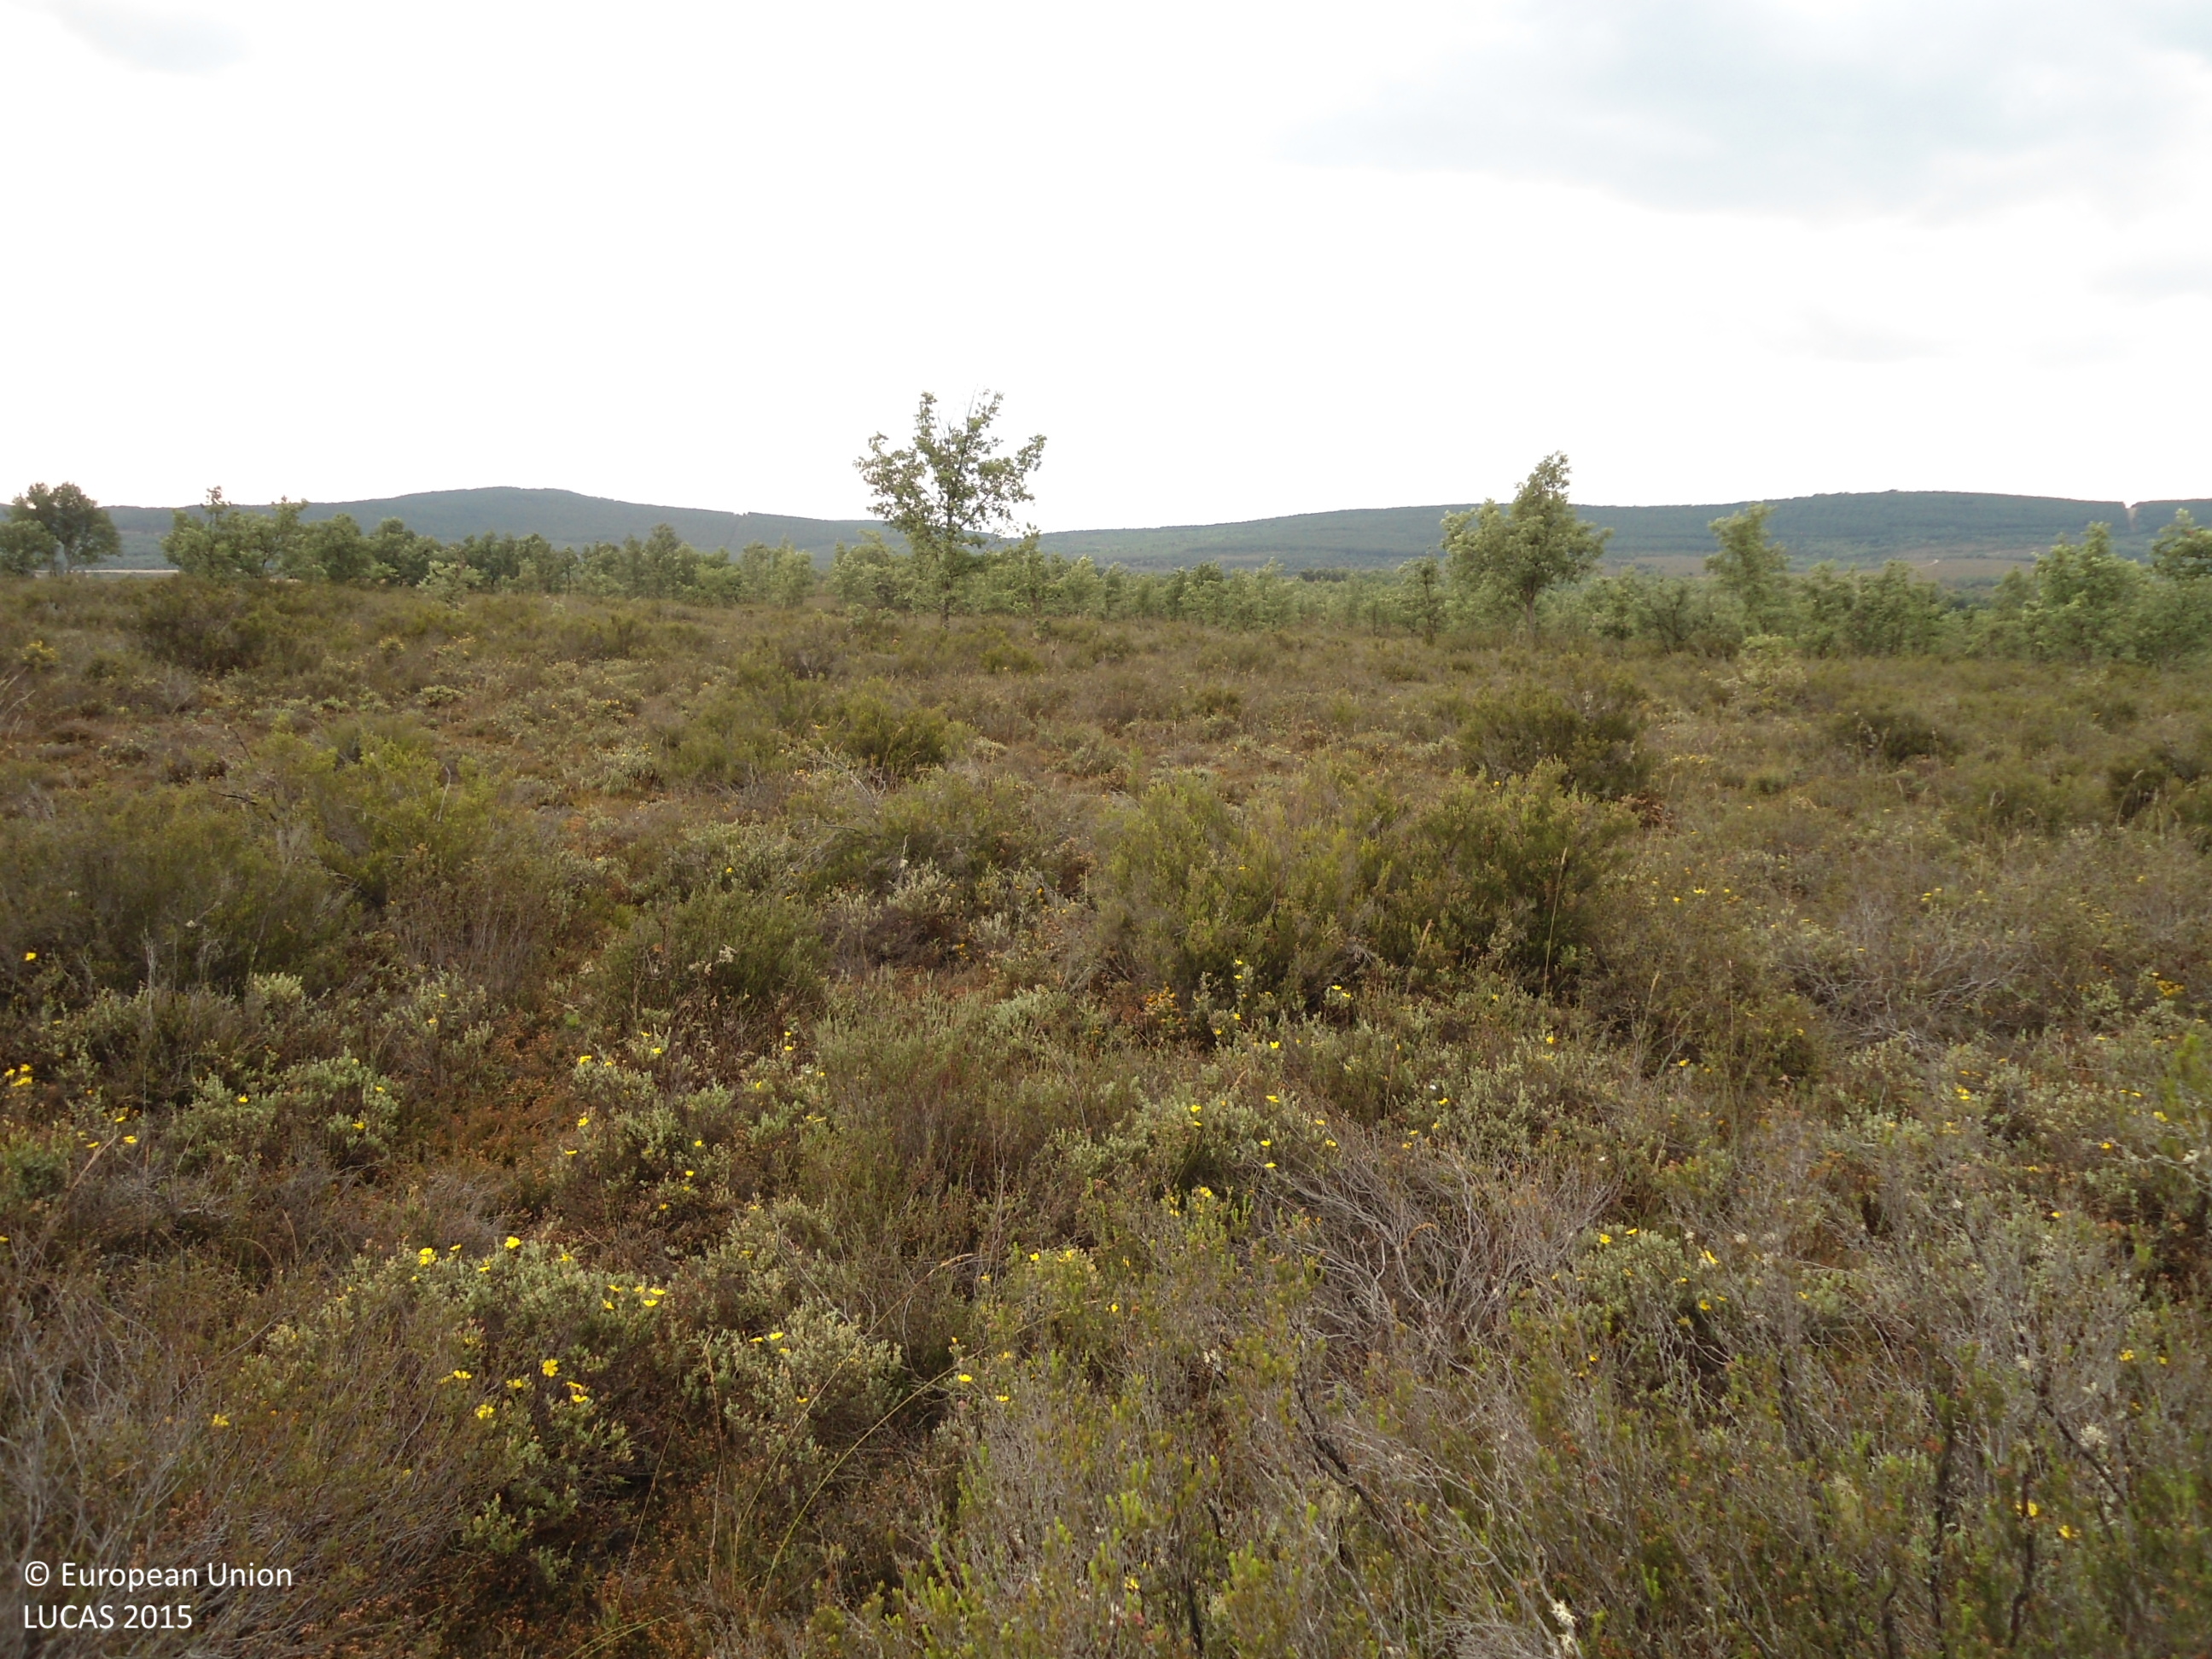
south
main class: Shrubland
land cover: Shrubland with sparse tree cover
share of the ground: > 75 %
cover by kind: shrubs 95 %, broadleaved forest trees 5 %
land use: Semi-natural and natural areas not in use
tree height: < 5 m
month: June
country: ES
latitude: 41.9455
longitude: -6.2058
